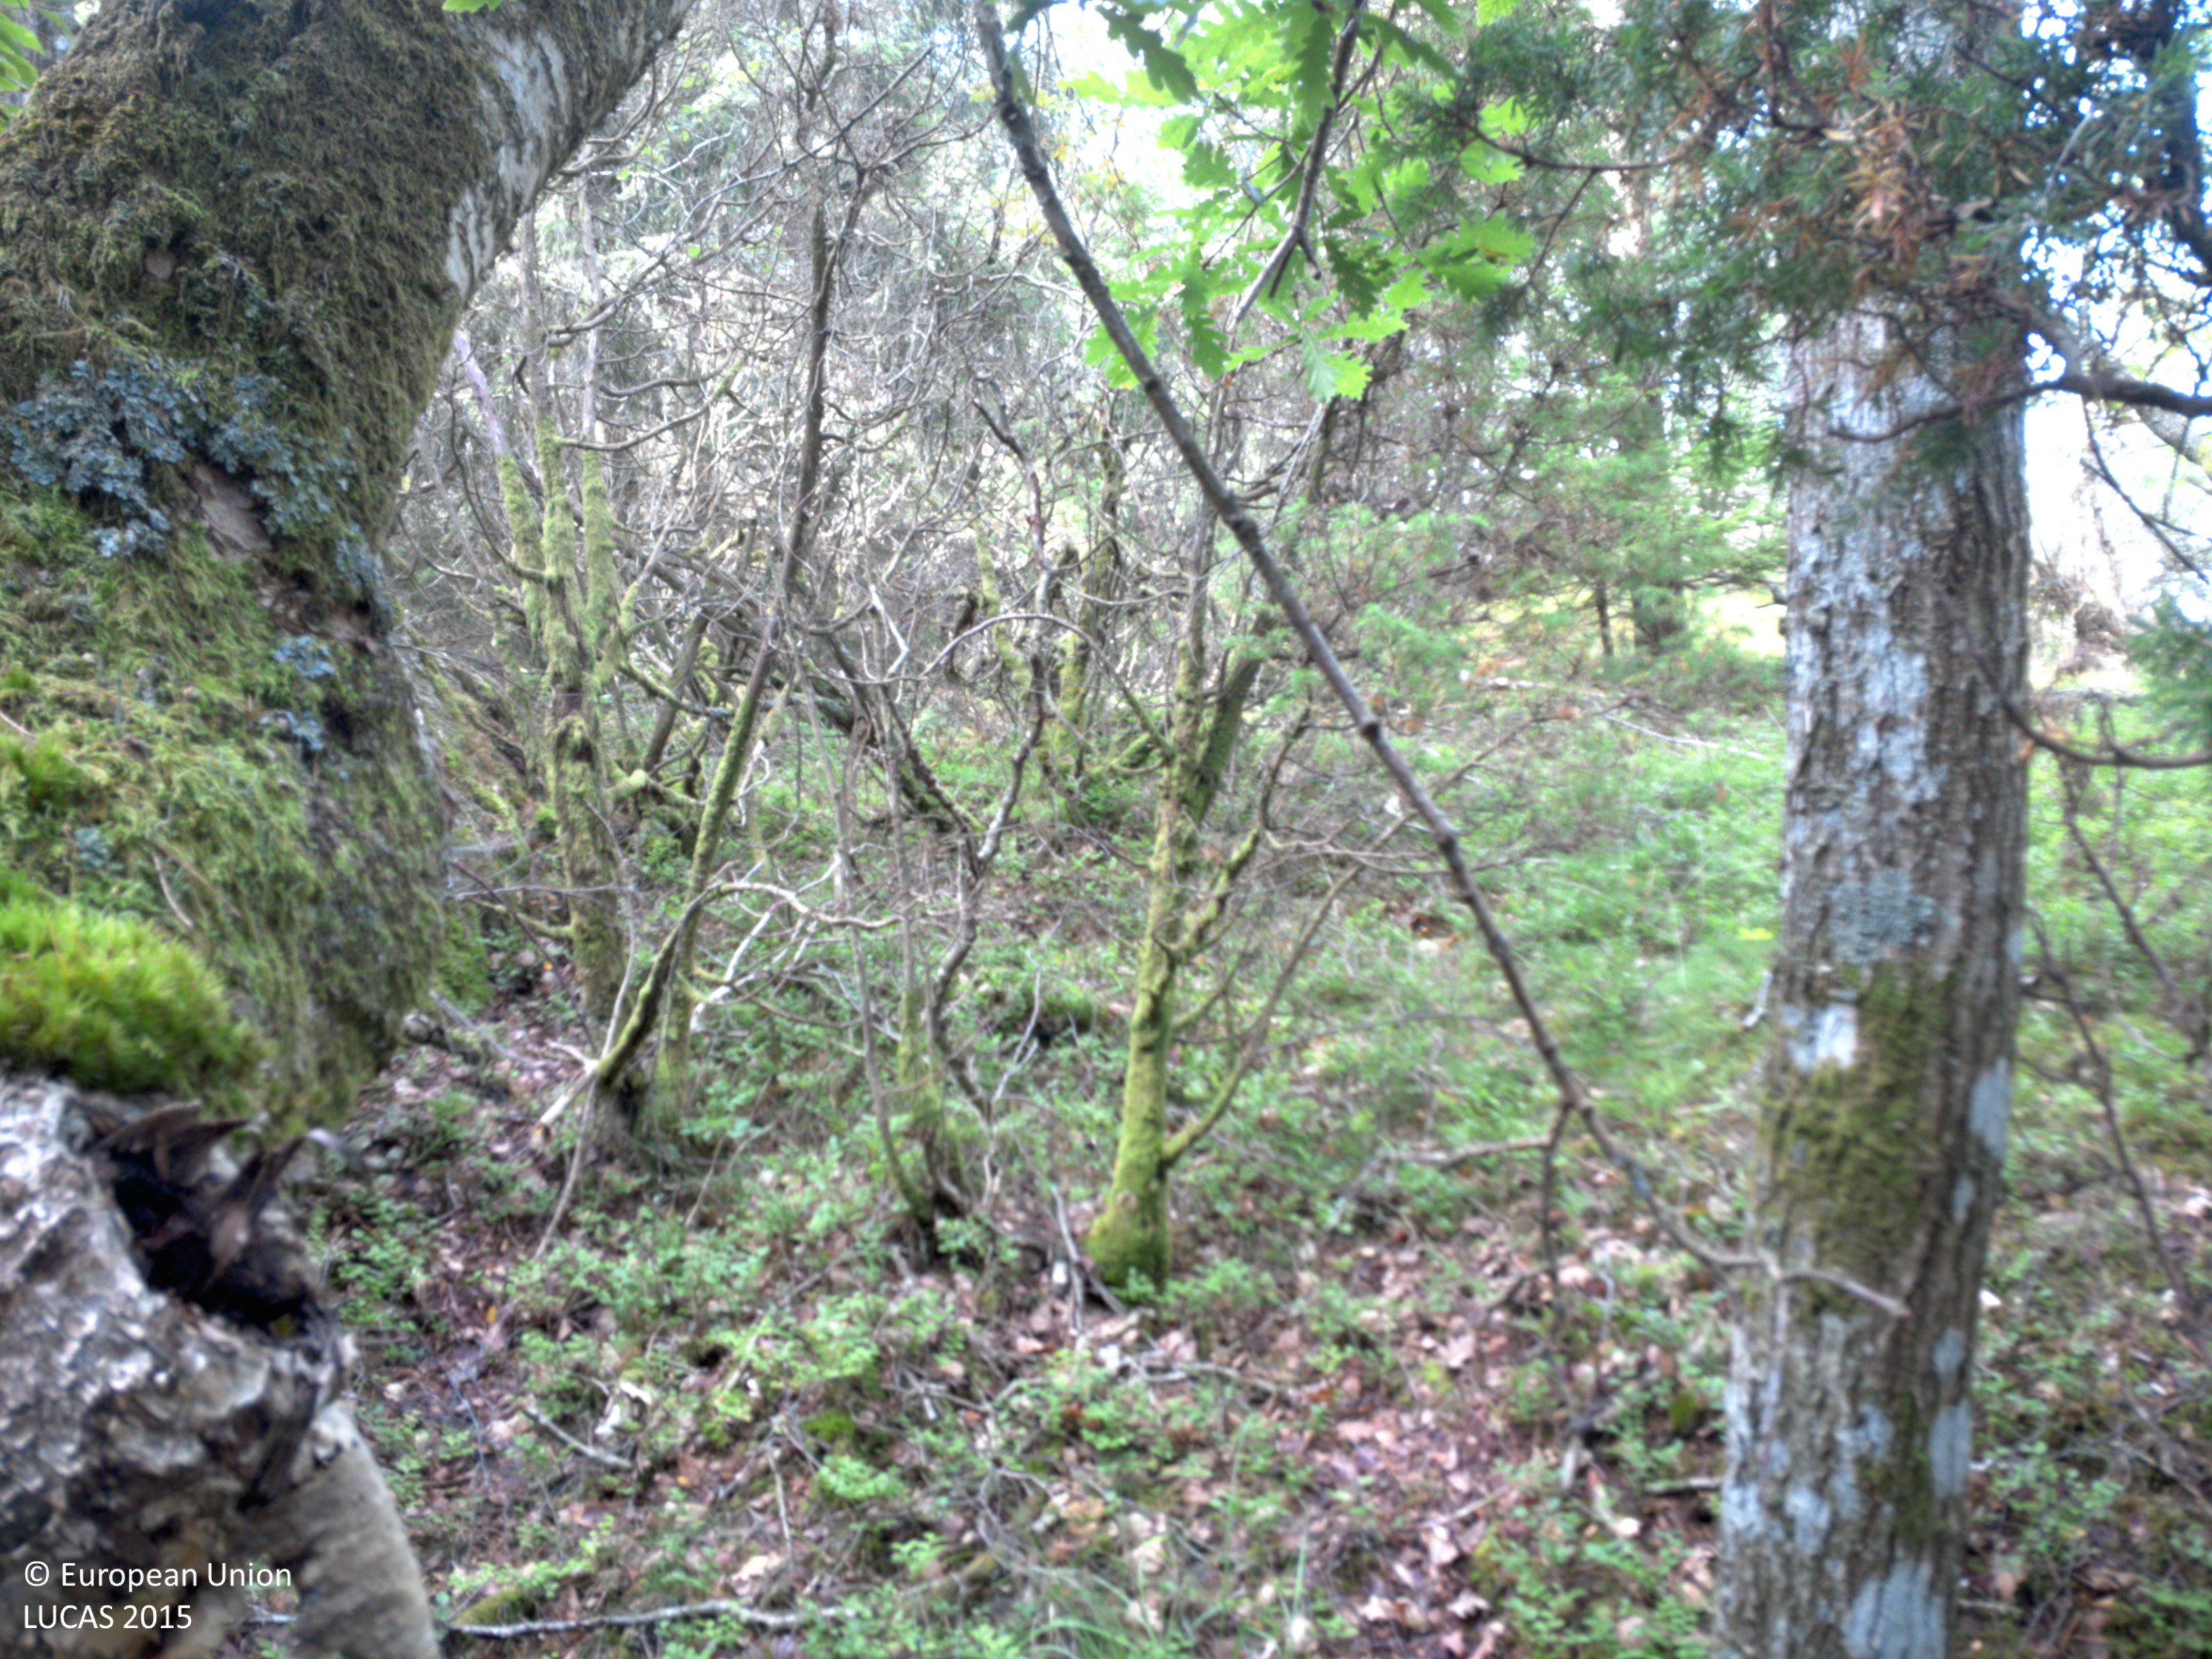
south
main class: Woodland
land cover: Spruce dominated mixed woodland
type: boreal forest
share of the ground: > 75 %
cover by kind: coniferous forest trees 40 %, broadleaved forest trees 35 %, herbaceous plants 25 %
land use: Forestry
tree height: > 5 m
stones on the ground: < 10 %
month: July
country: SE
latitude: 58.1742
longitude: 11.5781
